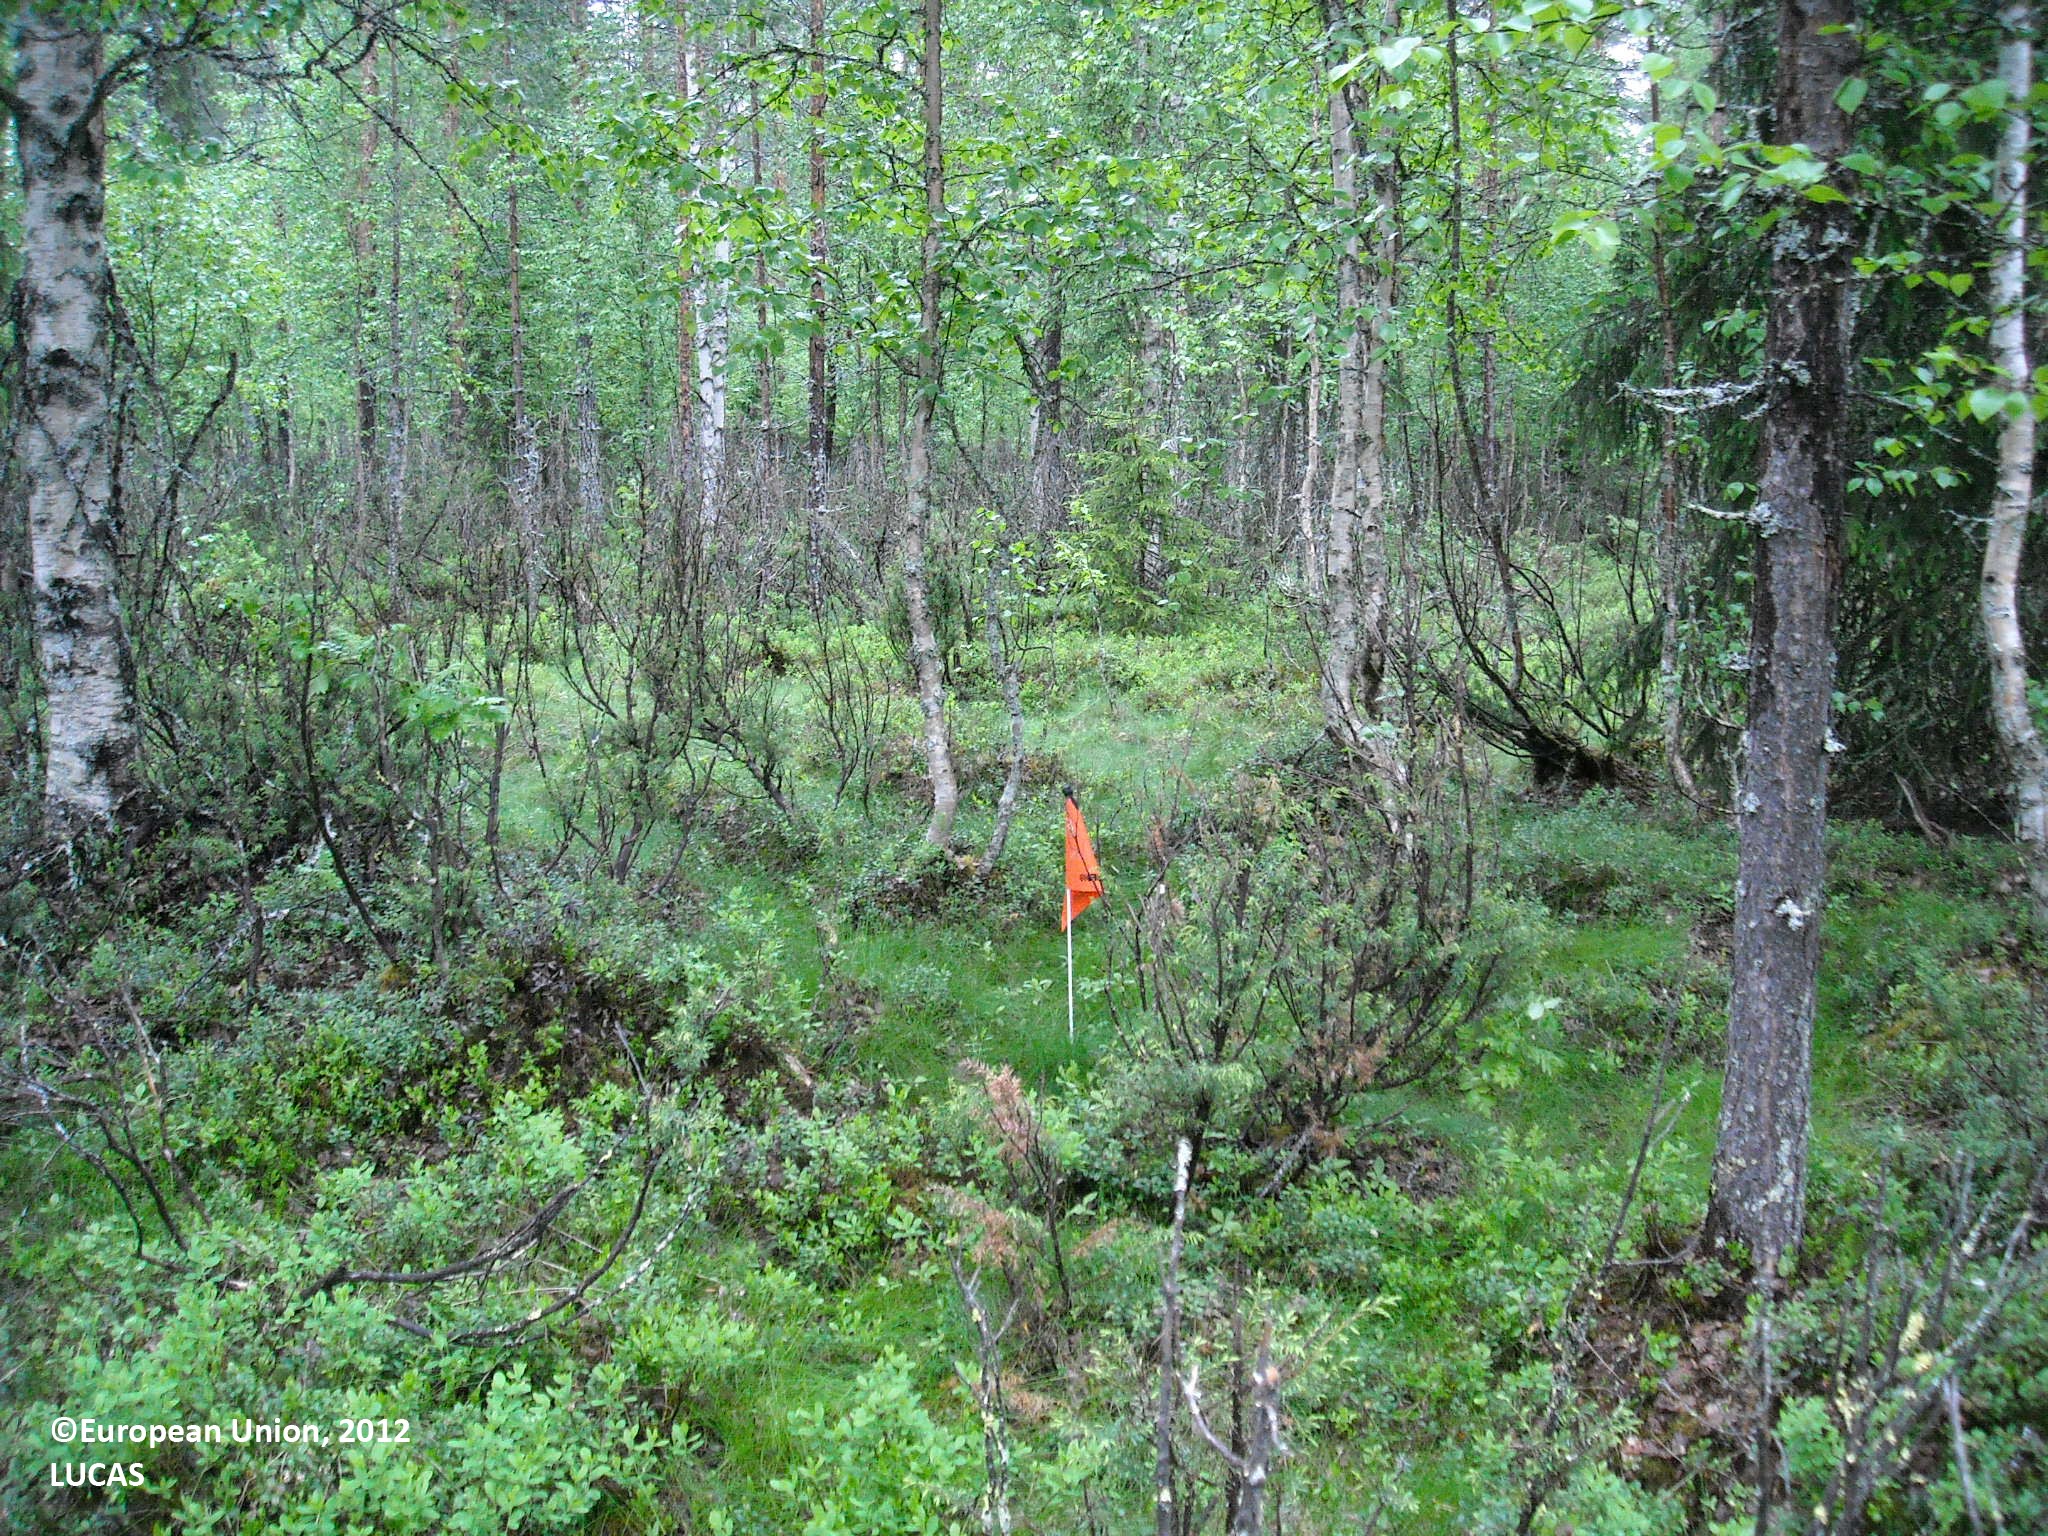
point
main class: Woodland
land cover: Other mixed woodland
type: boreal forest
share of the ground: > 75 %
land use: Forestry
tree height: > 5 m
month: June
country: FI
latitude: 65.4335
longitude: 27.9276
